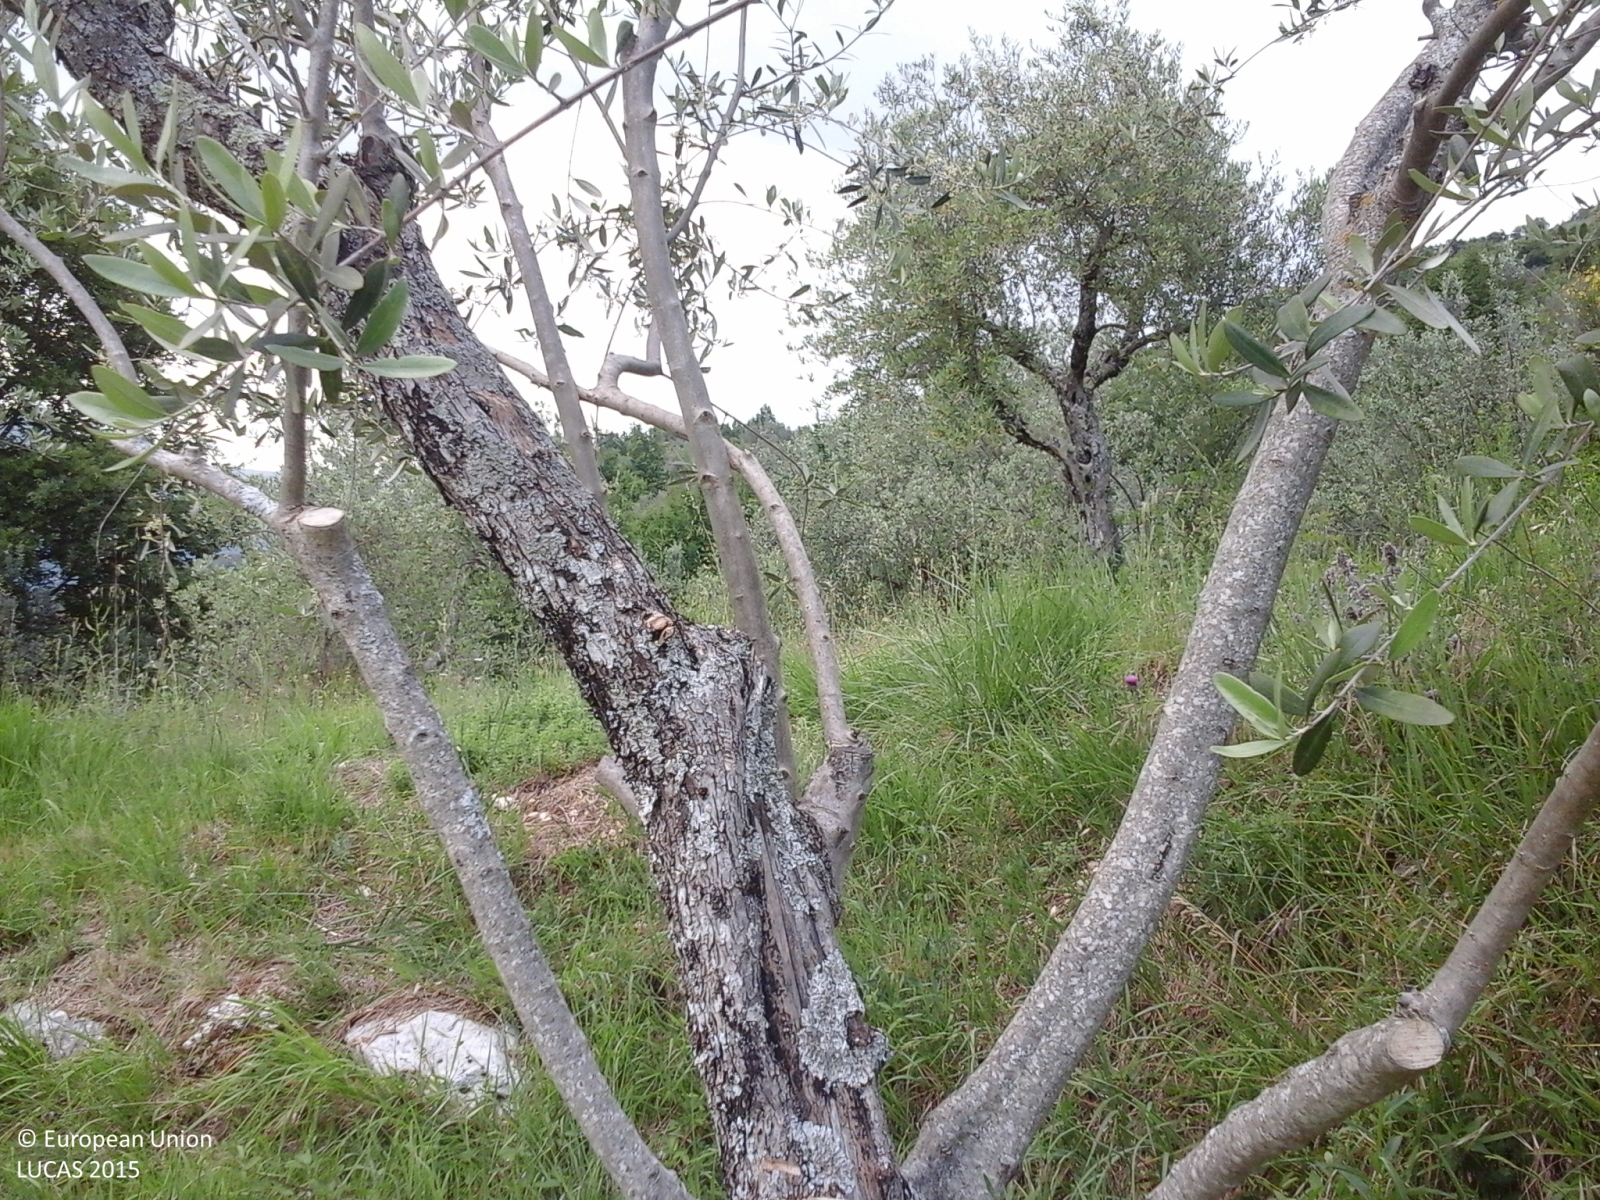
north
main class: Cropland
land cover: Olive groves
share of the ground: > 75 %
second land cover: Grassland without tree/shrub cover
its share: 50 - 75 %
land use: Agriculture (excluding fallow land and kitchen gardens)
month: June
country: IT
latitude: 41.7003
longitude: 13.6997
